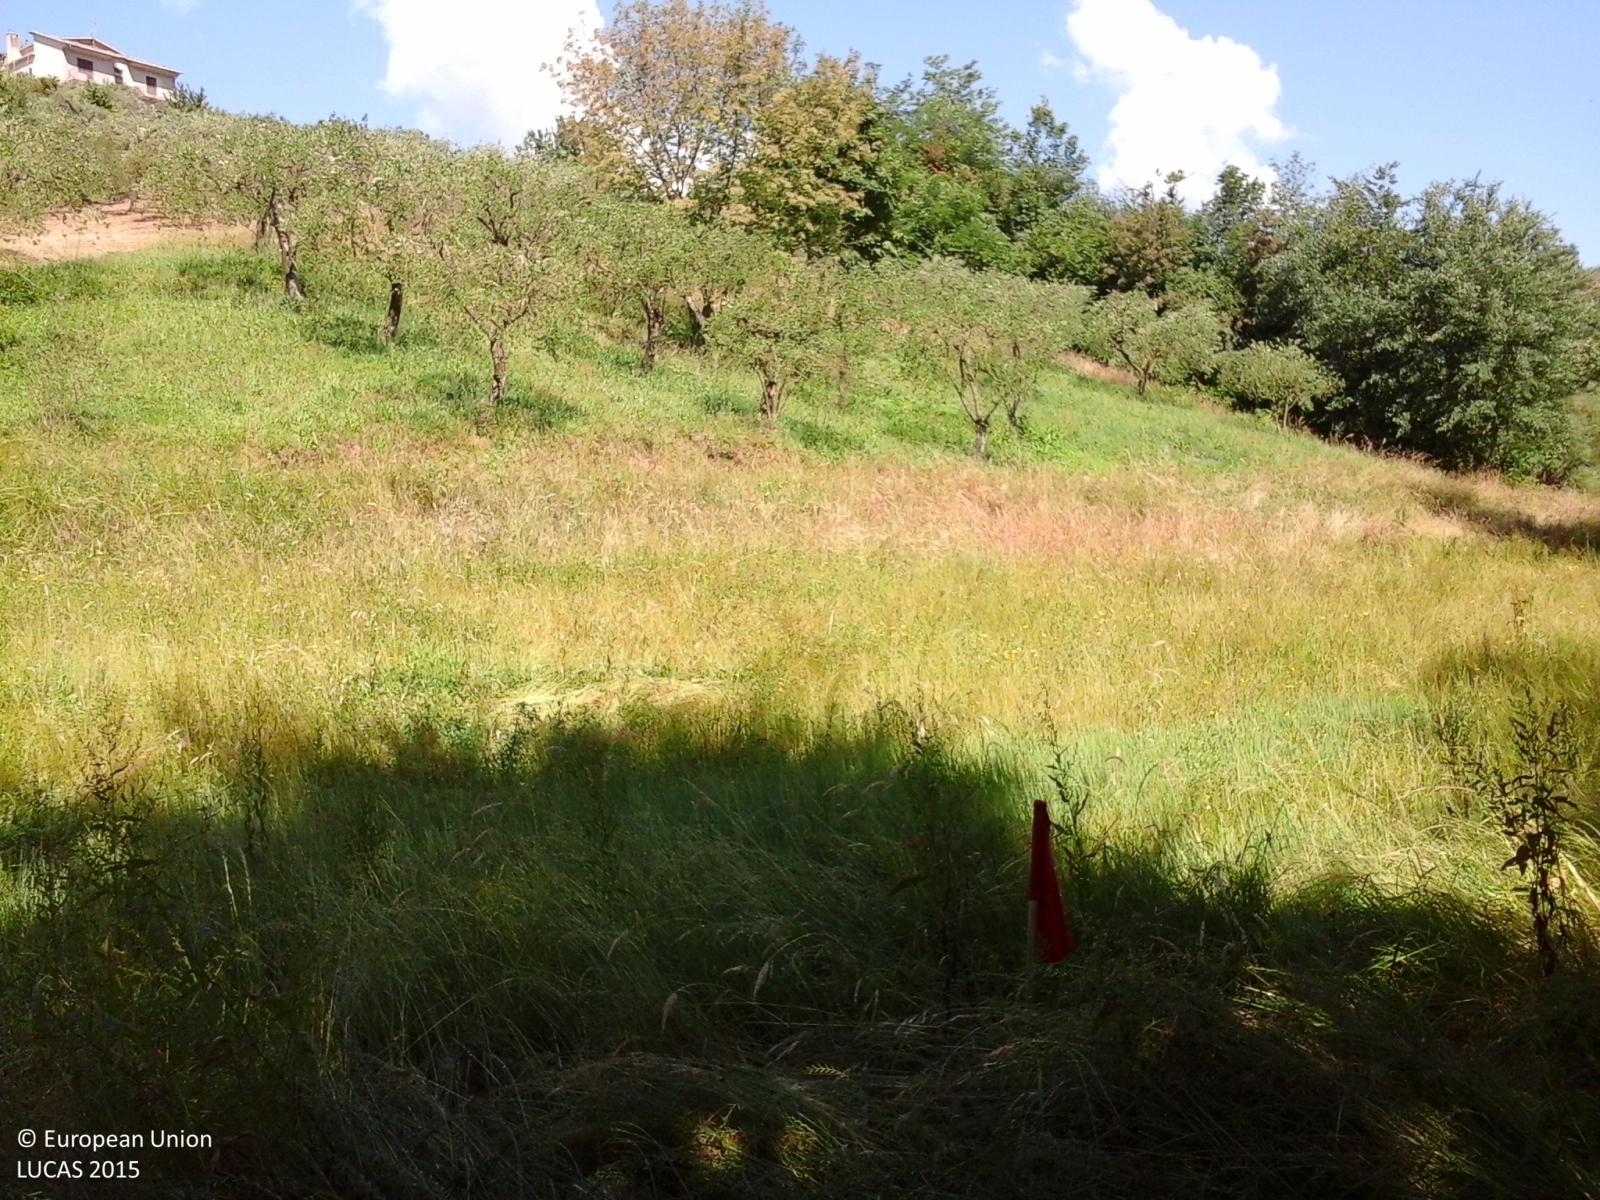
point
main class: Grassland
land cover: Grassland with sparse tree/shrub cover
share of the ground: 50 - 75 %
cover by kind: herbaceous plants 90 %, broadleaved forest trees 5 %, shrubs 5 %
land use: Agriculture (excluding fallow land and kitchen gardens)
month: May
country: IT
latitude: 41.6933
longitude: 13.3877
